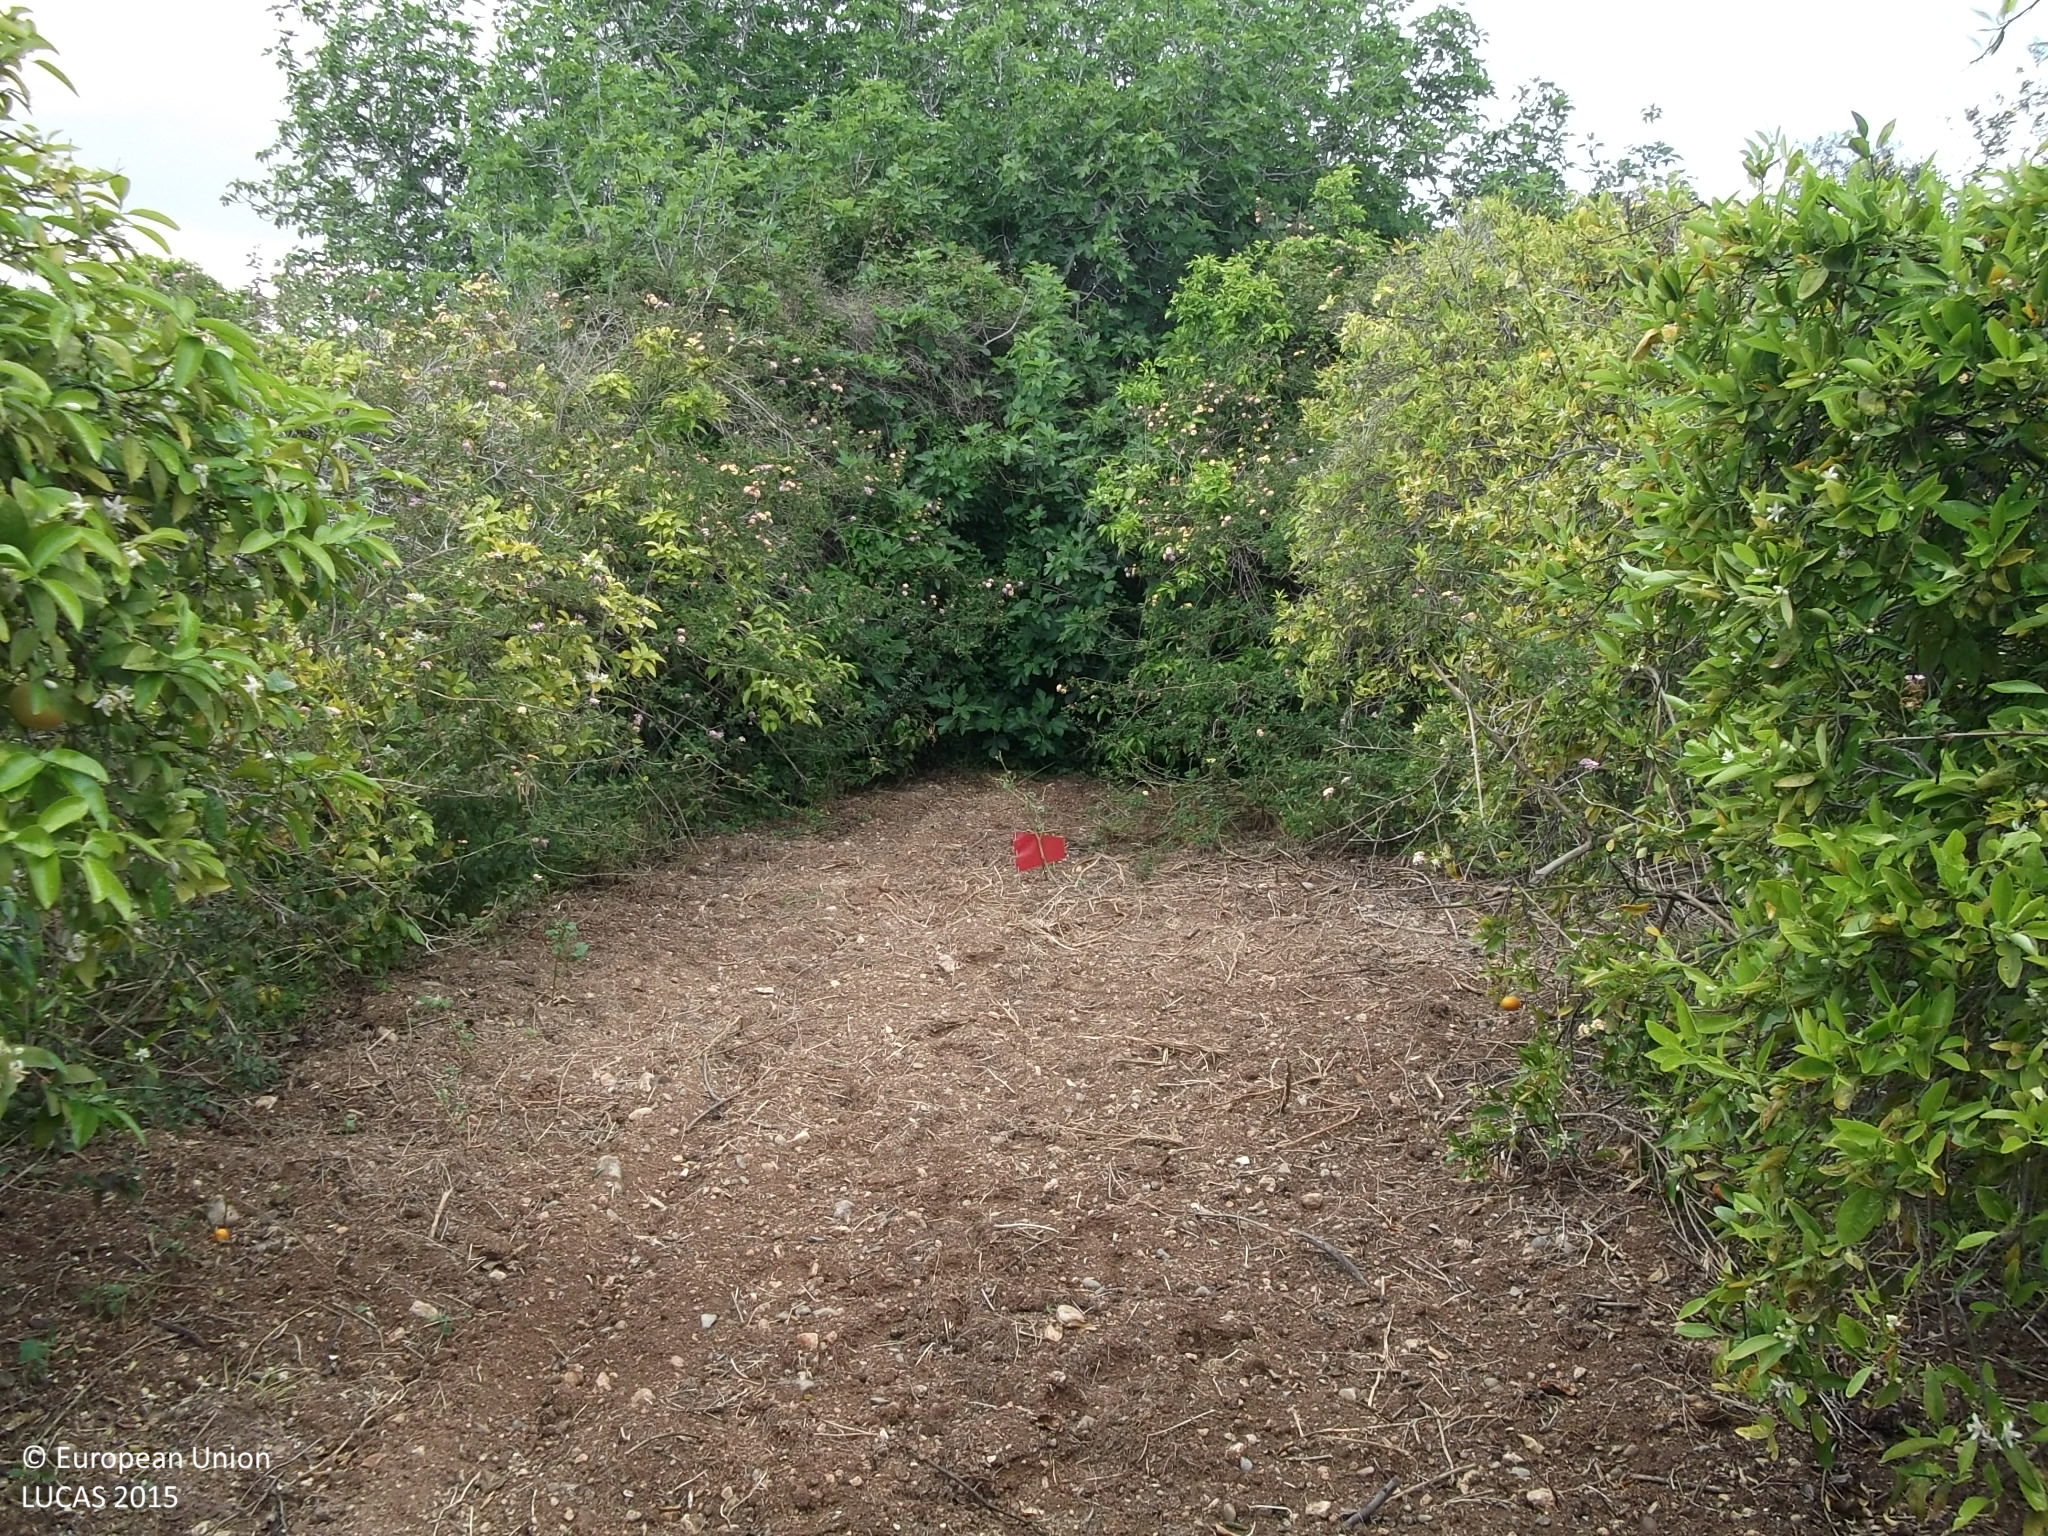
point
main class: Cropland
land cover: Other citrus fruit
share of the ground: > 75 %
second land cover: Other bare soil
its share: > 75 %
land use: Agriculture (excluding fallow land and kitchen gardens)
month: April
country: CY
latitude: 34.7606
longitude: 33.4200
